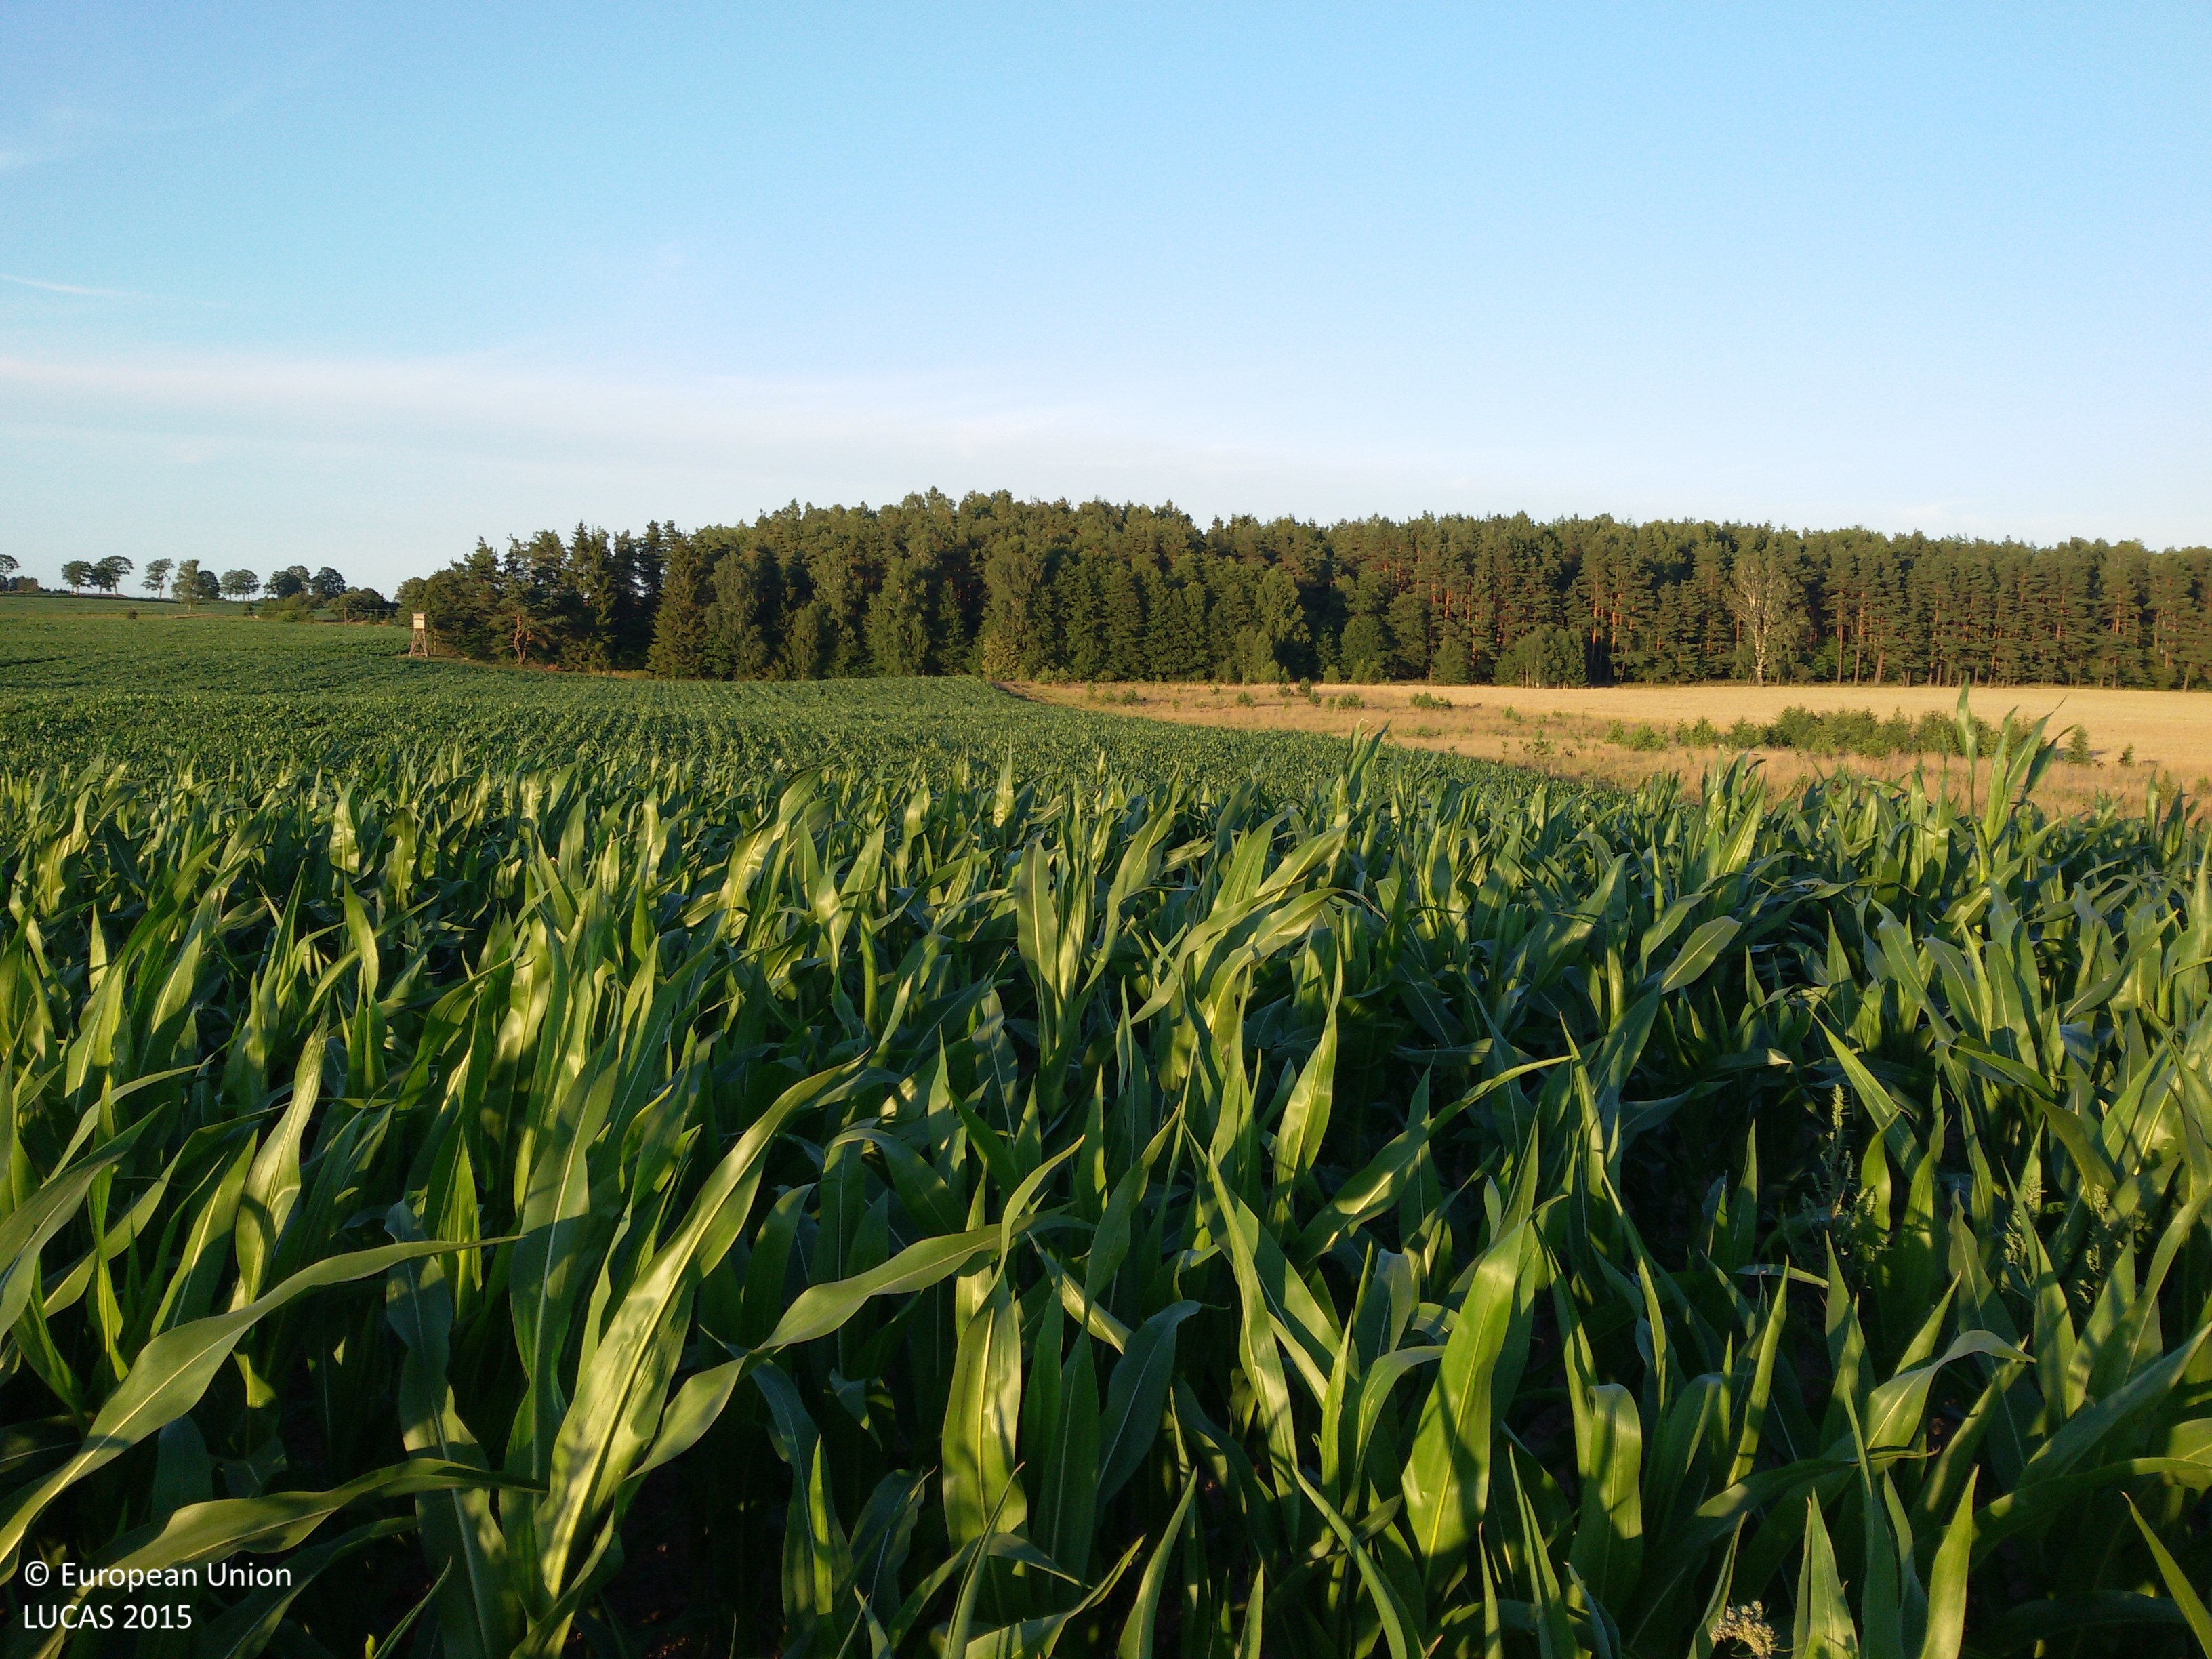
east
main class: Cropland
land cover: Maize
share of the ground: > 75 %
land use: Agriculture (excluding fallow land and kitchen gardens)
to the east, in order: Maize
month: July
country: PL
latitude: 53.6725
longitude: 21.0790
